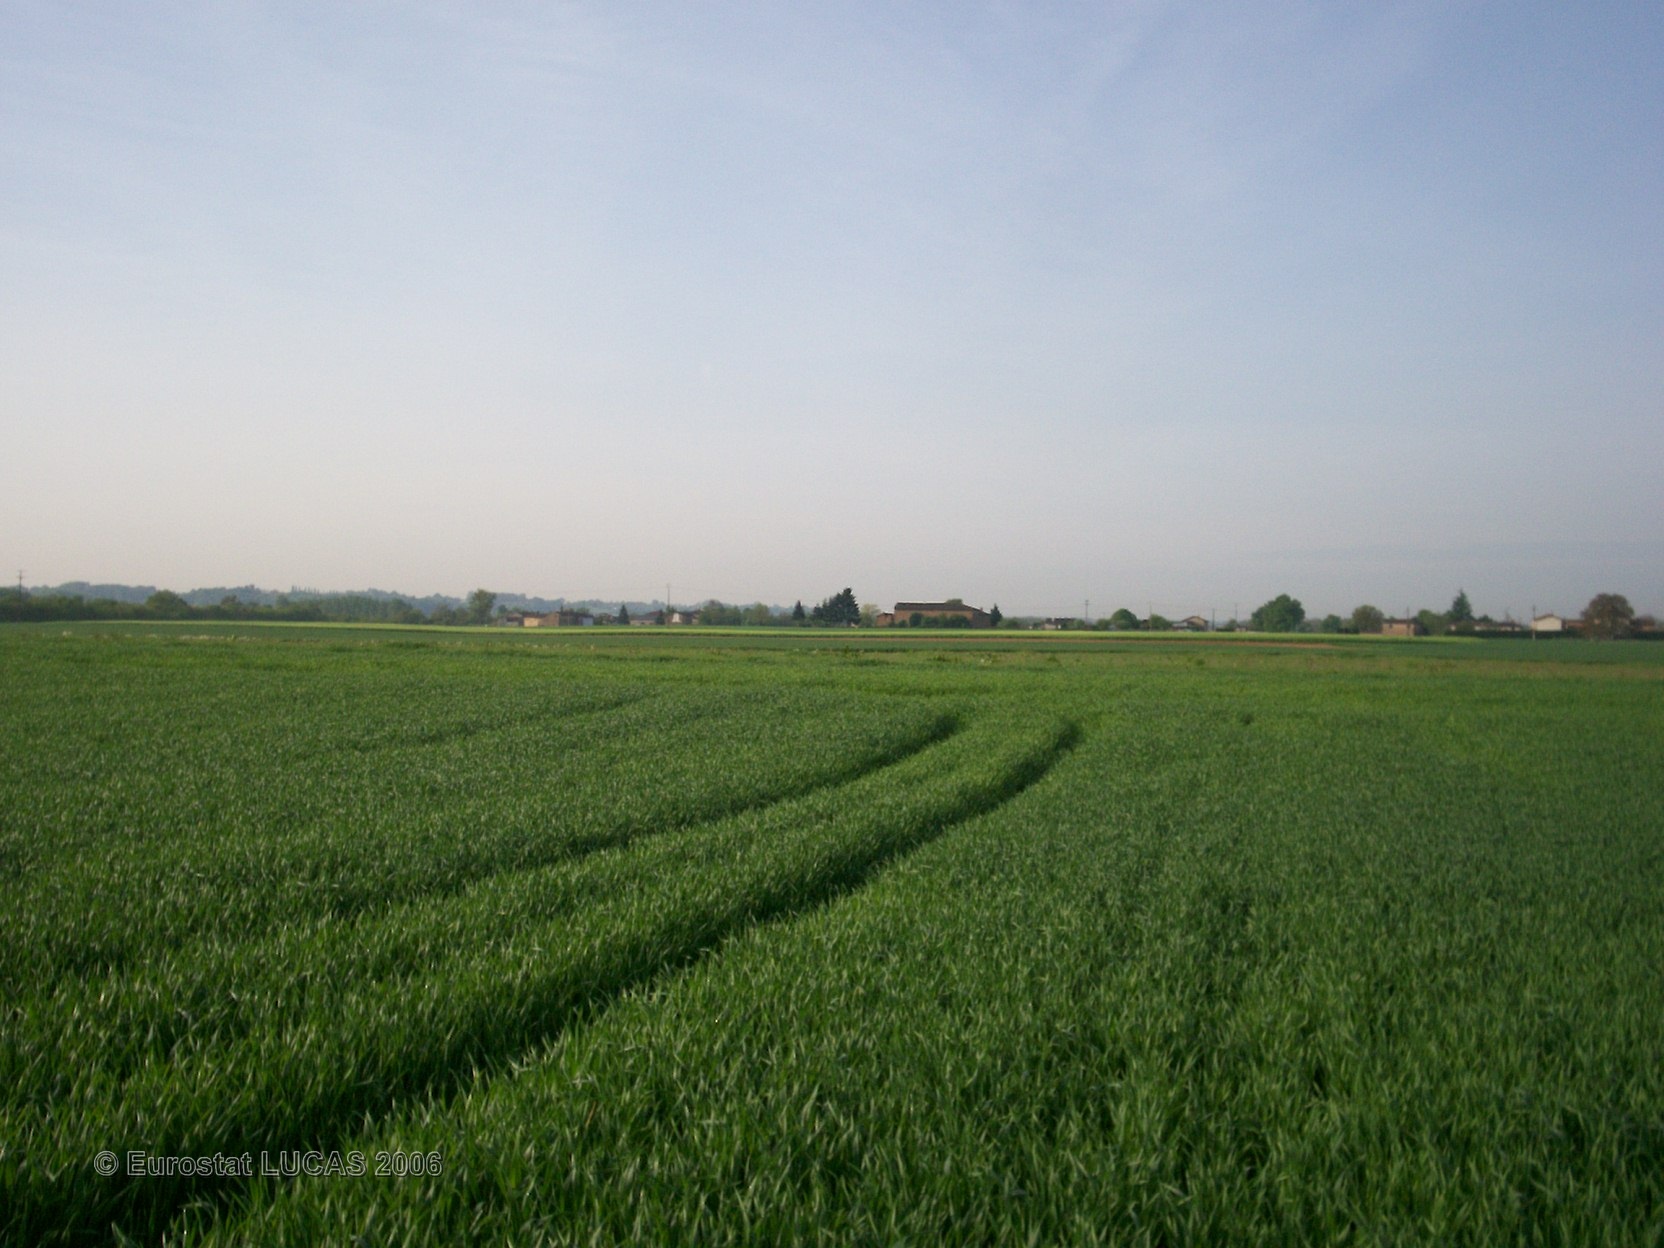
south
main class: Cropland
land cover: Common wheat
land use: Agriculture (excluding fallow land and kitchen gardens)
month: May
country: FR
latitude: 46.1518
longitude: 4.7846
